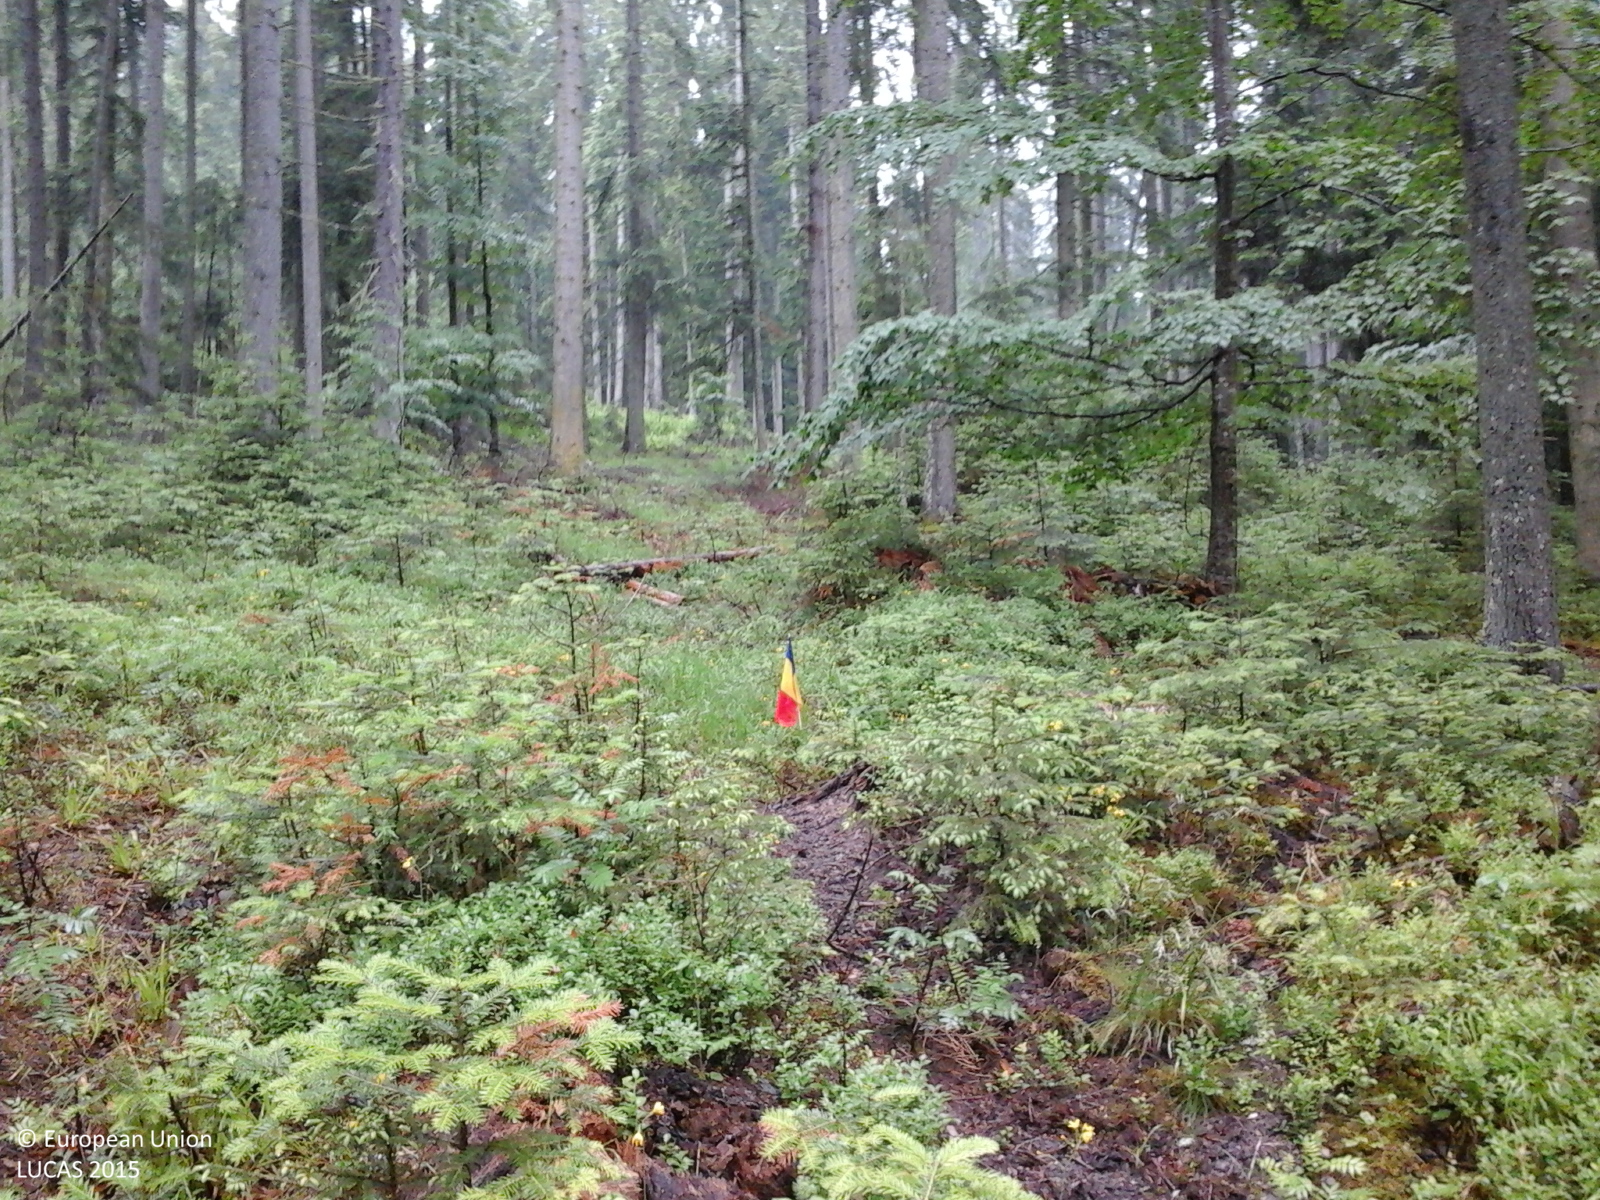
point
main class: Woodland
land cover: Spruce dominated mixed woodland
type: alpine coniferous forest
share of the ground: > 75 %
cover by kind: coniferous forest trees 70 %, broadleaved forest trees 30 %
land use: Forestry
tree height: > 5 m
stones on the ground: 10 - 25 %
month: June
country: RO
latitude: 47.5576
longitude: 25.2474
